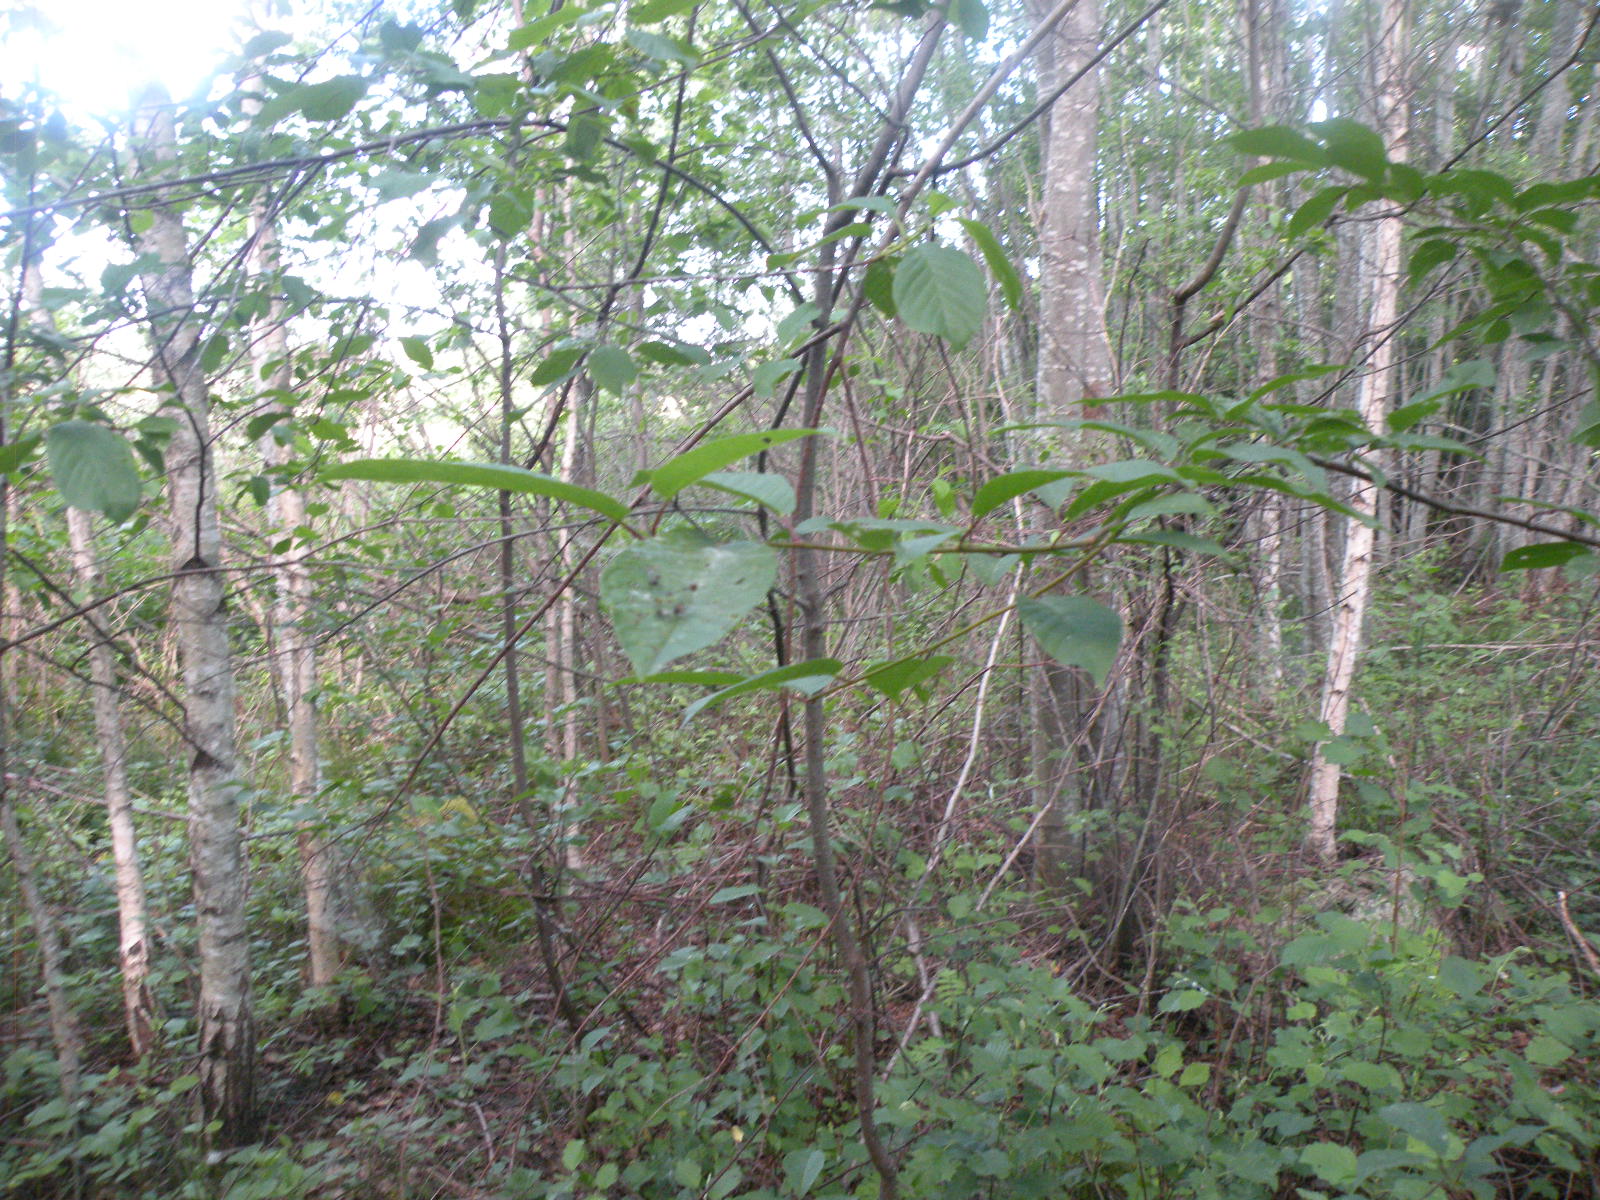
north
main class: Woodland
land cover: Broadleaved woodland
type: non-riverine alder, birch or aspen forest
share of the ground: > 75 %
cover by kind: broadleaved forest trees 80 %, shrubs 10 %, herbaceous plants 10 %
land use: Forestry
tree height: > 5 m
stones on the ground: < 10 %
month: June
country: LV
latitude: 55.9053
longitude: 27.0095
